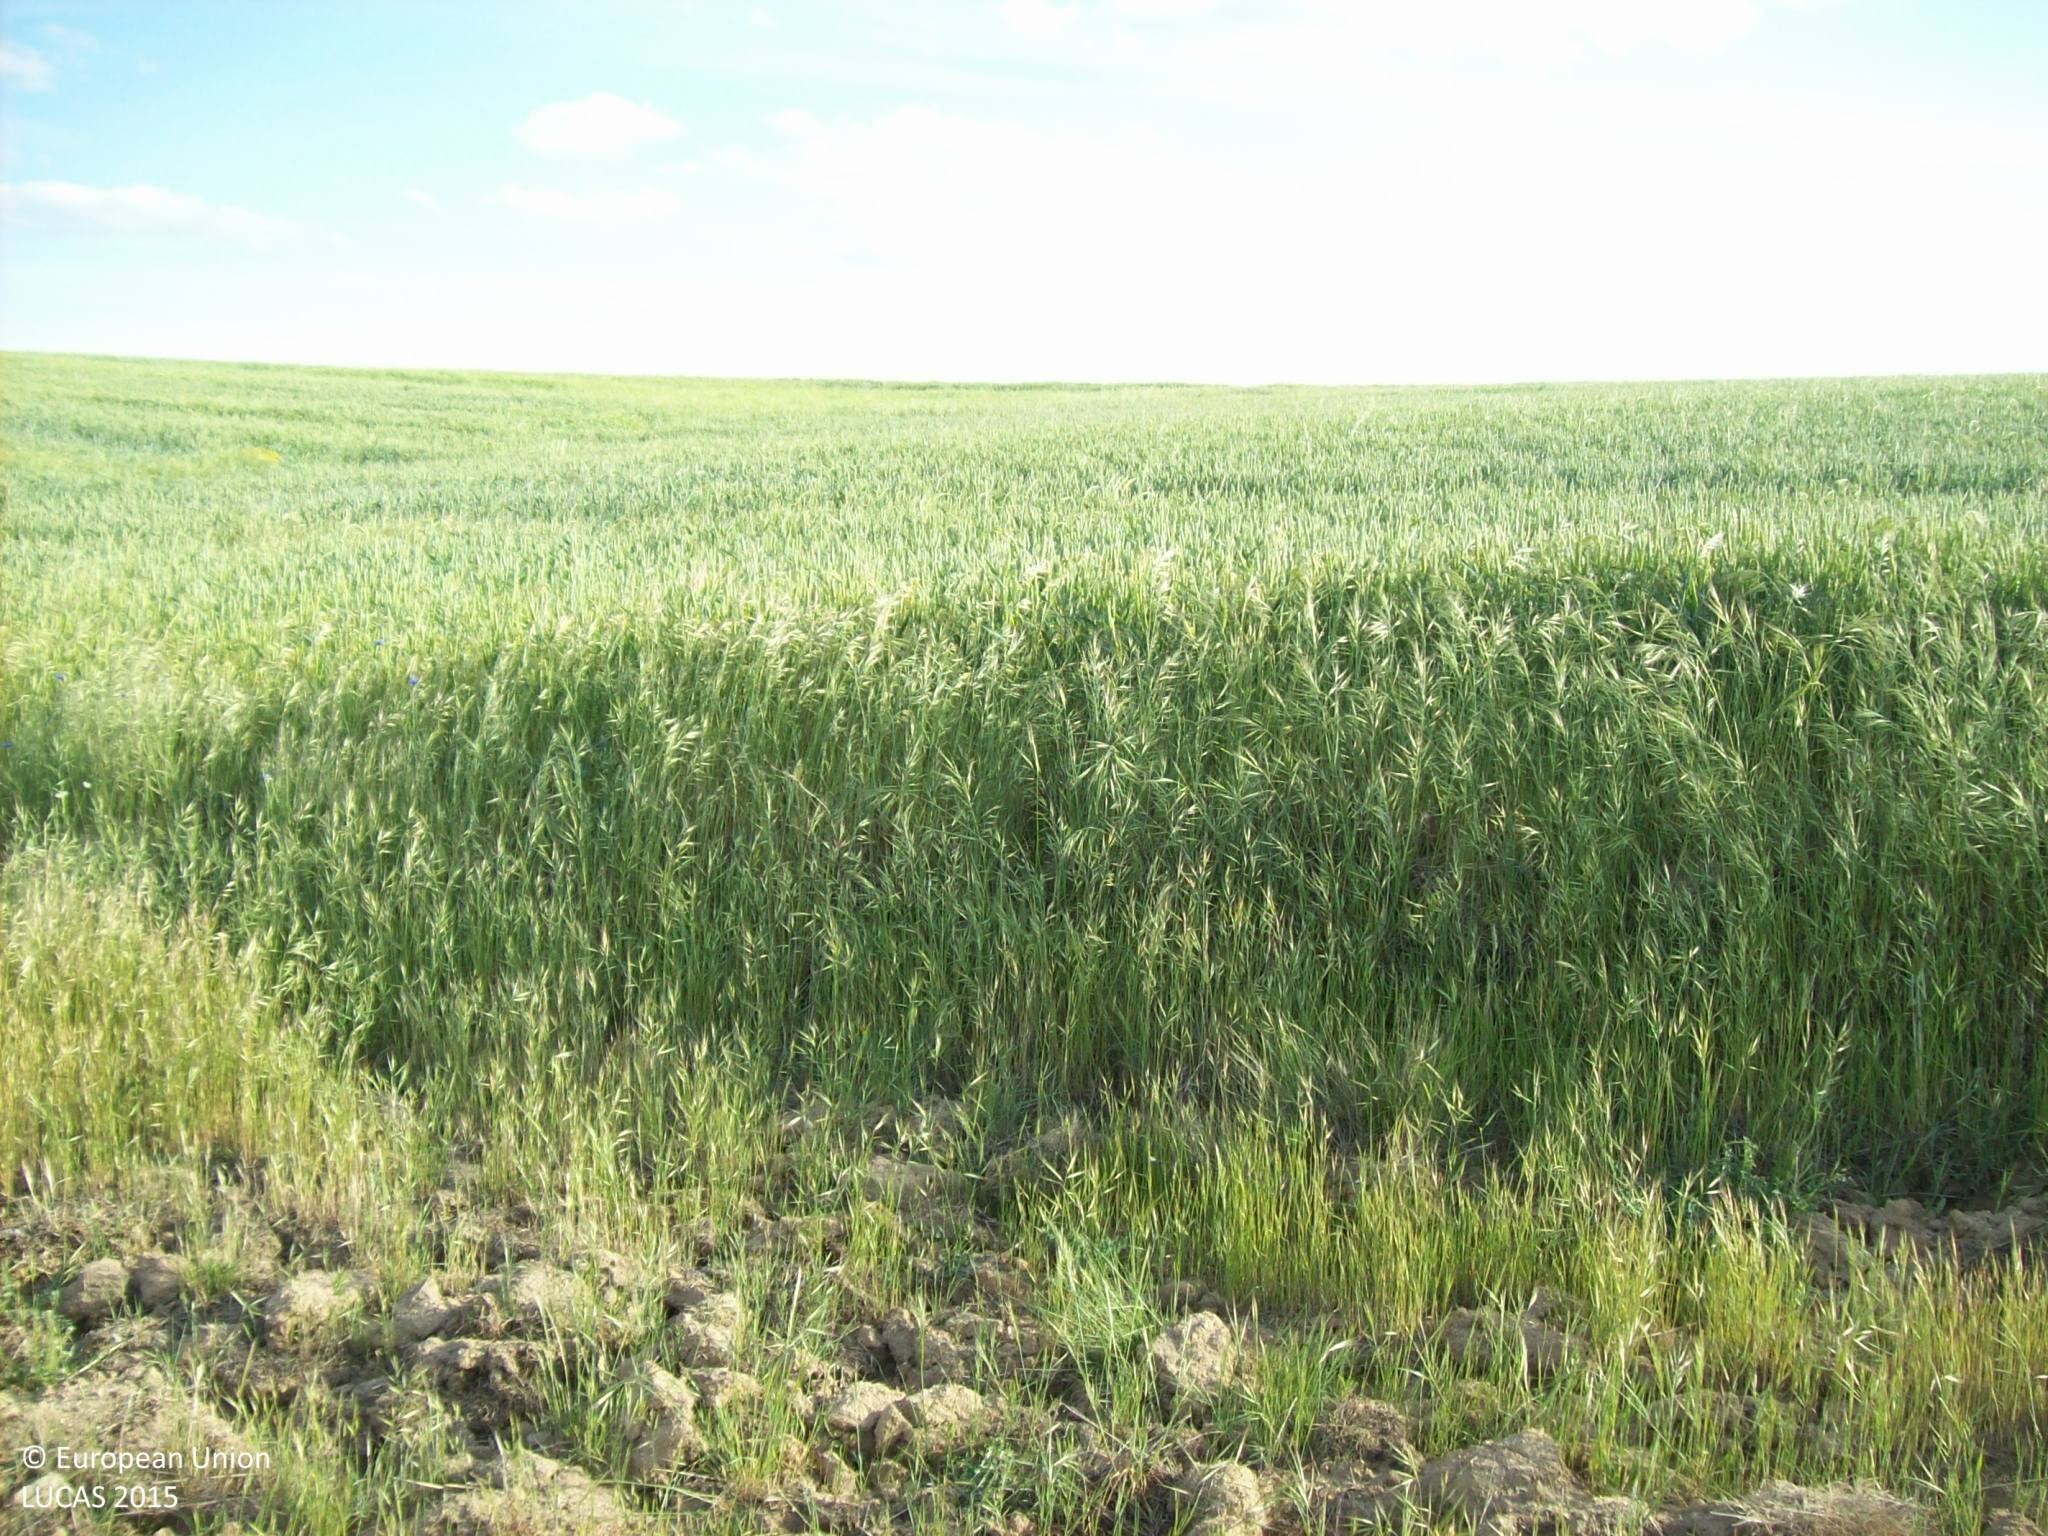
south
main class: Grassland
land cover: Grassland without tree/shrub cover
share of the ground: > 75 %
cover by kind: herbaceous plants 80 %, unconsolidated bare surface 15 %
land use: Semi-natural and natural areas not in use
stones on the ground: < 10 %
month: May
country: ES
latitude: 40.8188
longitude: -4.4831
